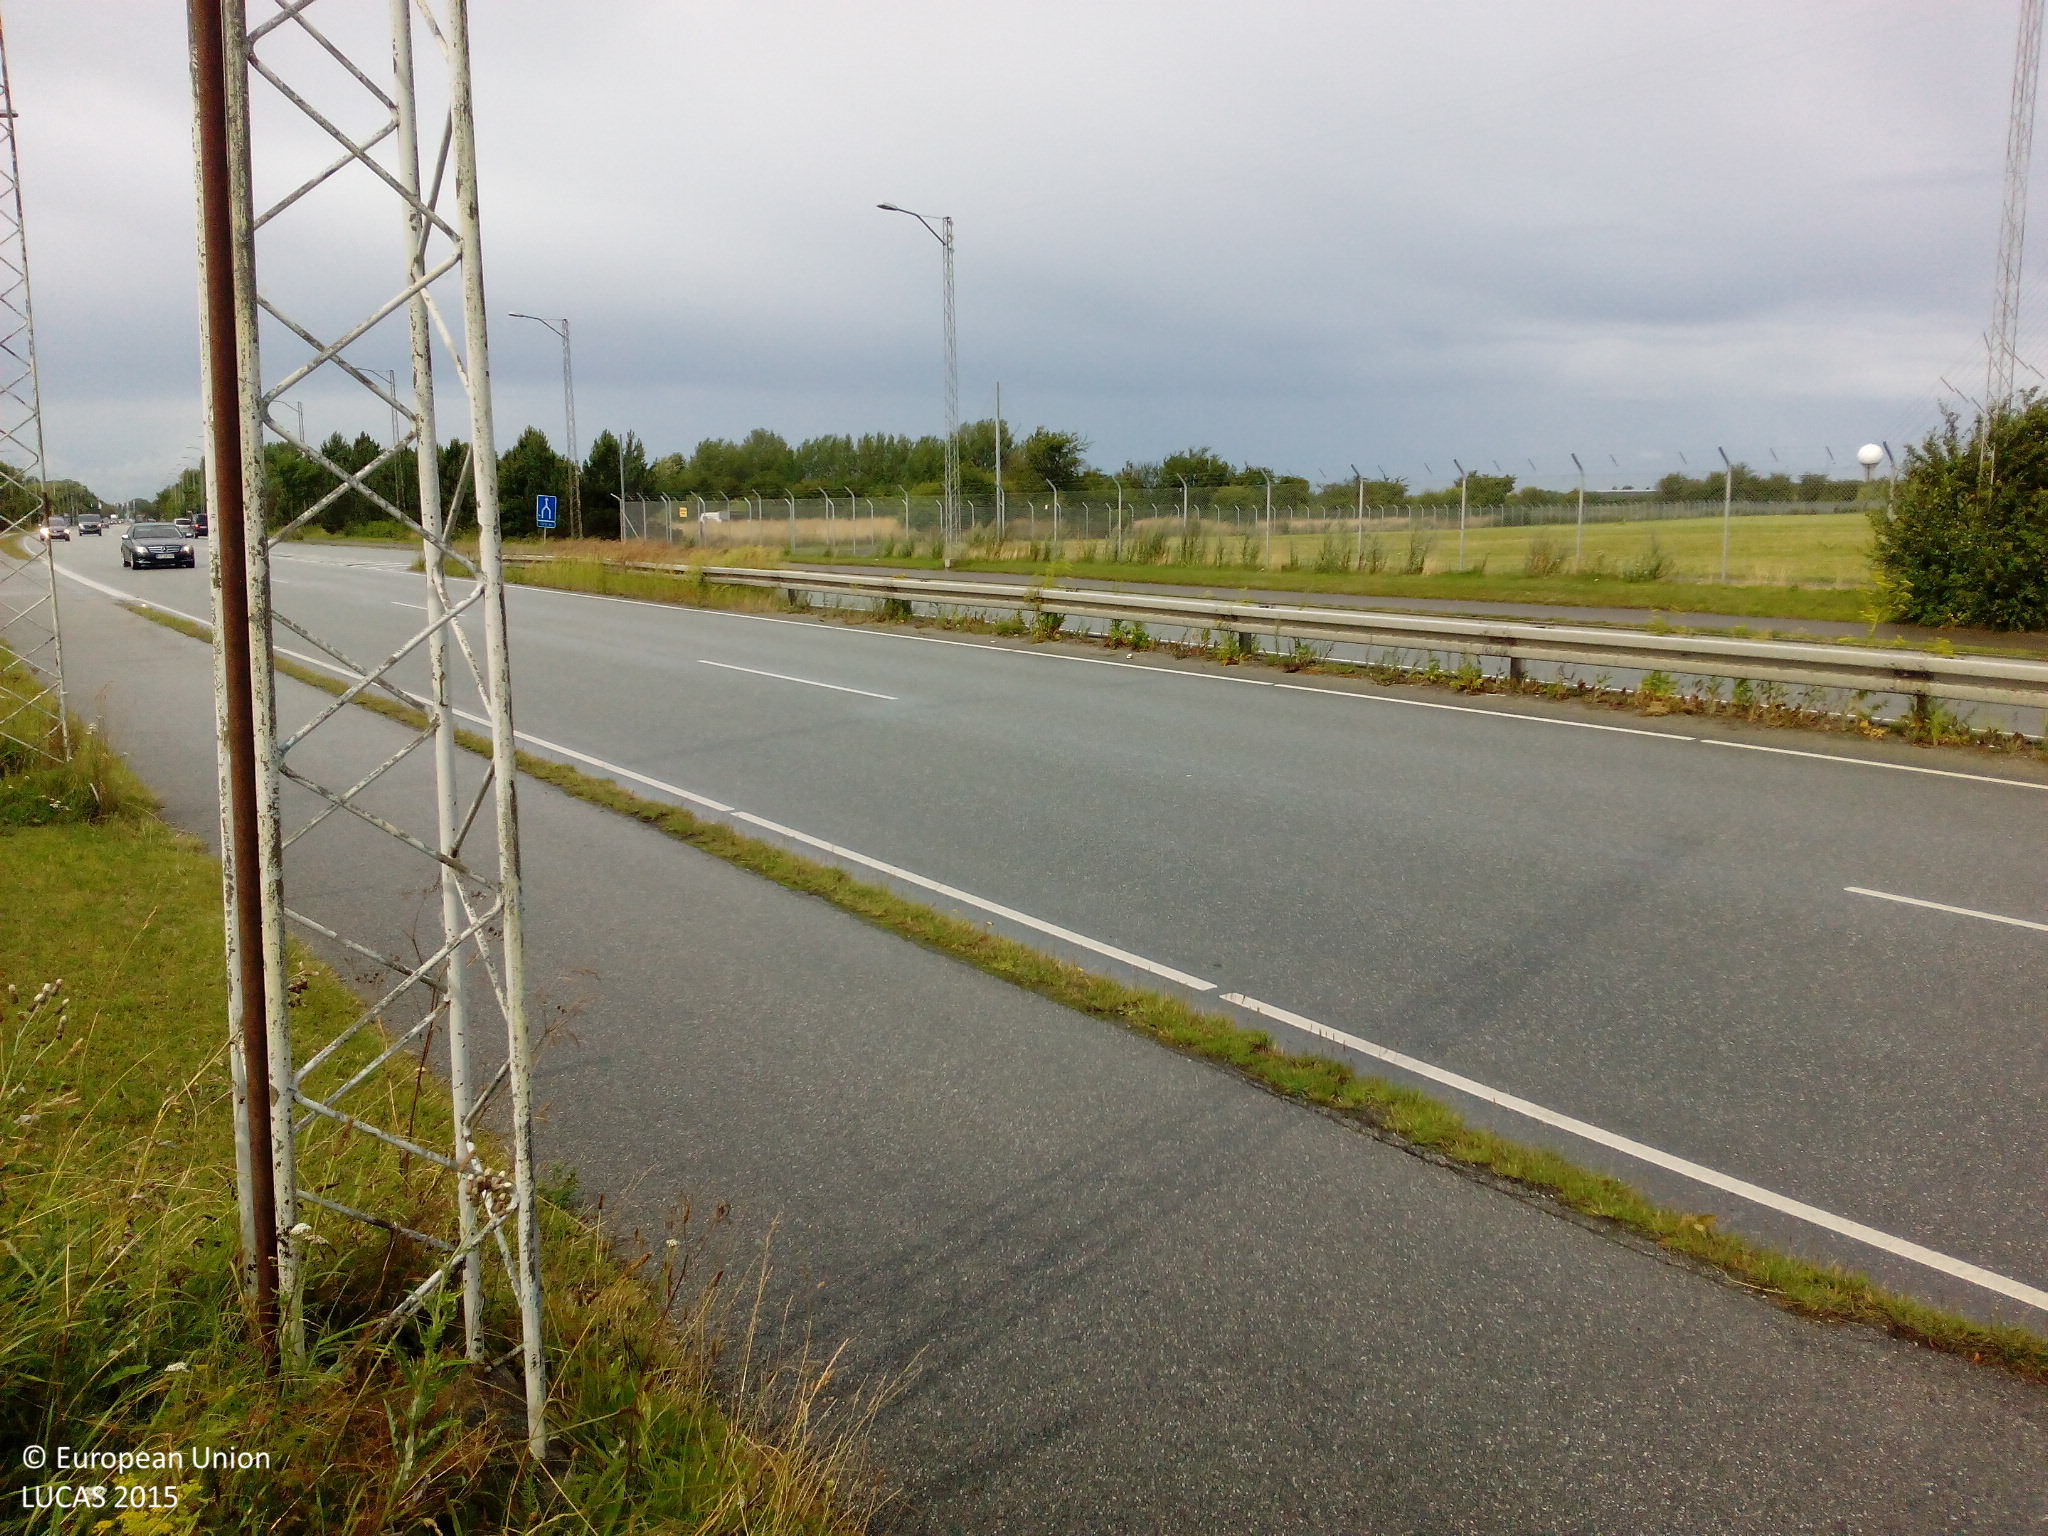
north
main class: Grassland
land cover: Grassland without tree/shrub cover
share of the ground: > 75 %
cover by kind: herbaceous plants 100 %
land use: Air transport
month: July
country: DK
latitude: 55.6036
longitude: 12.6170
